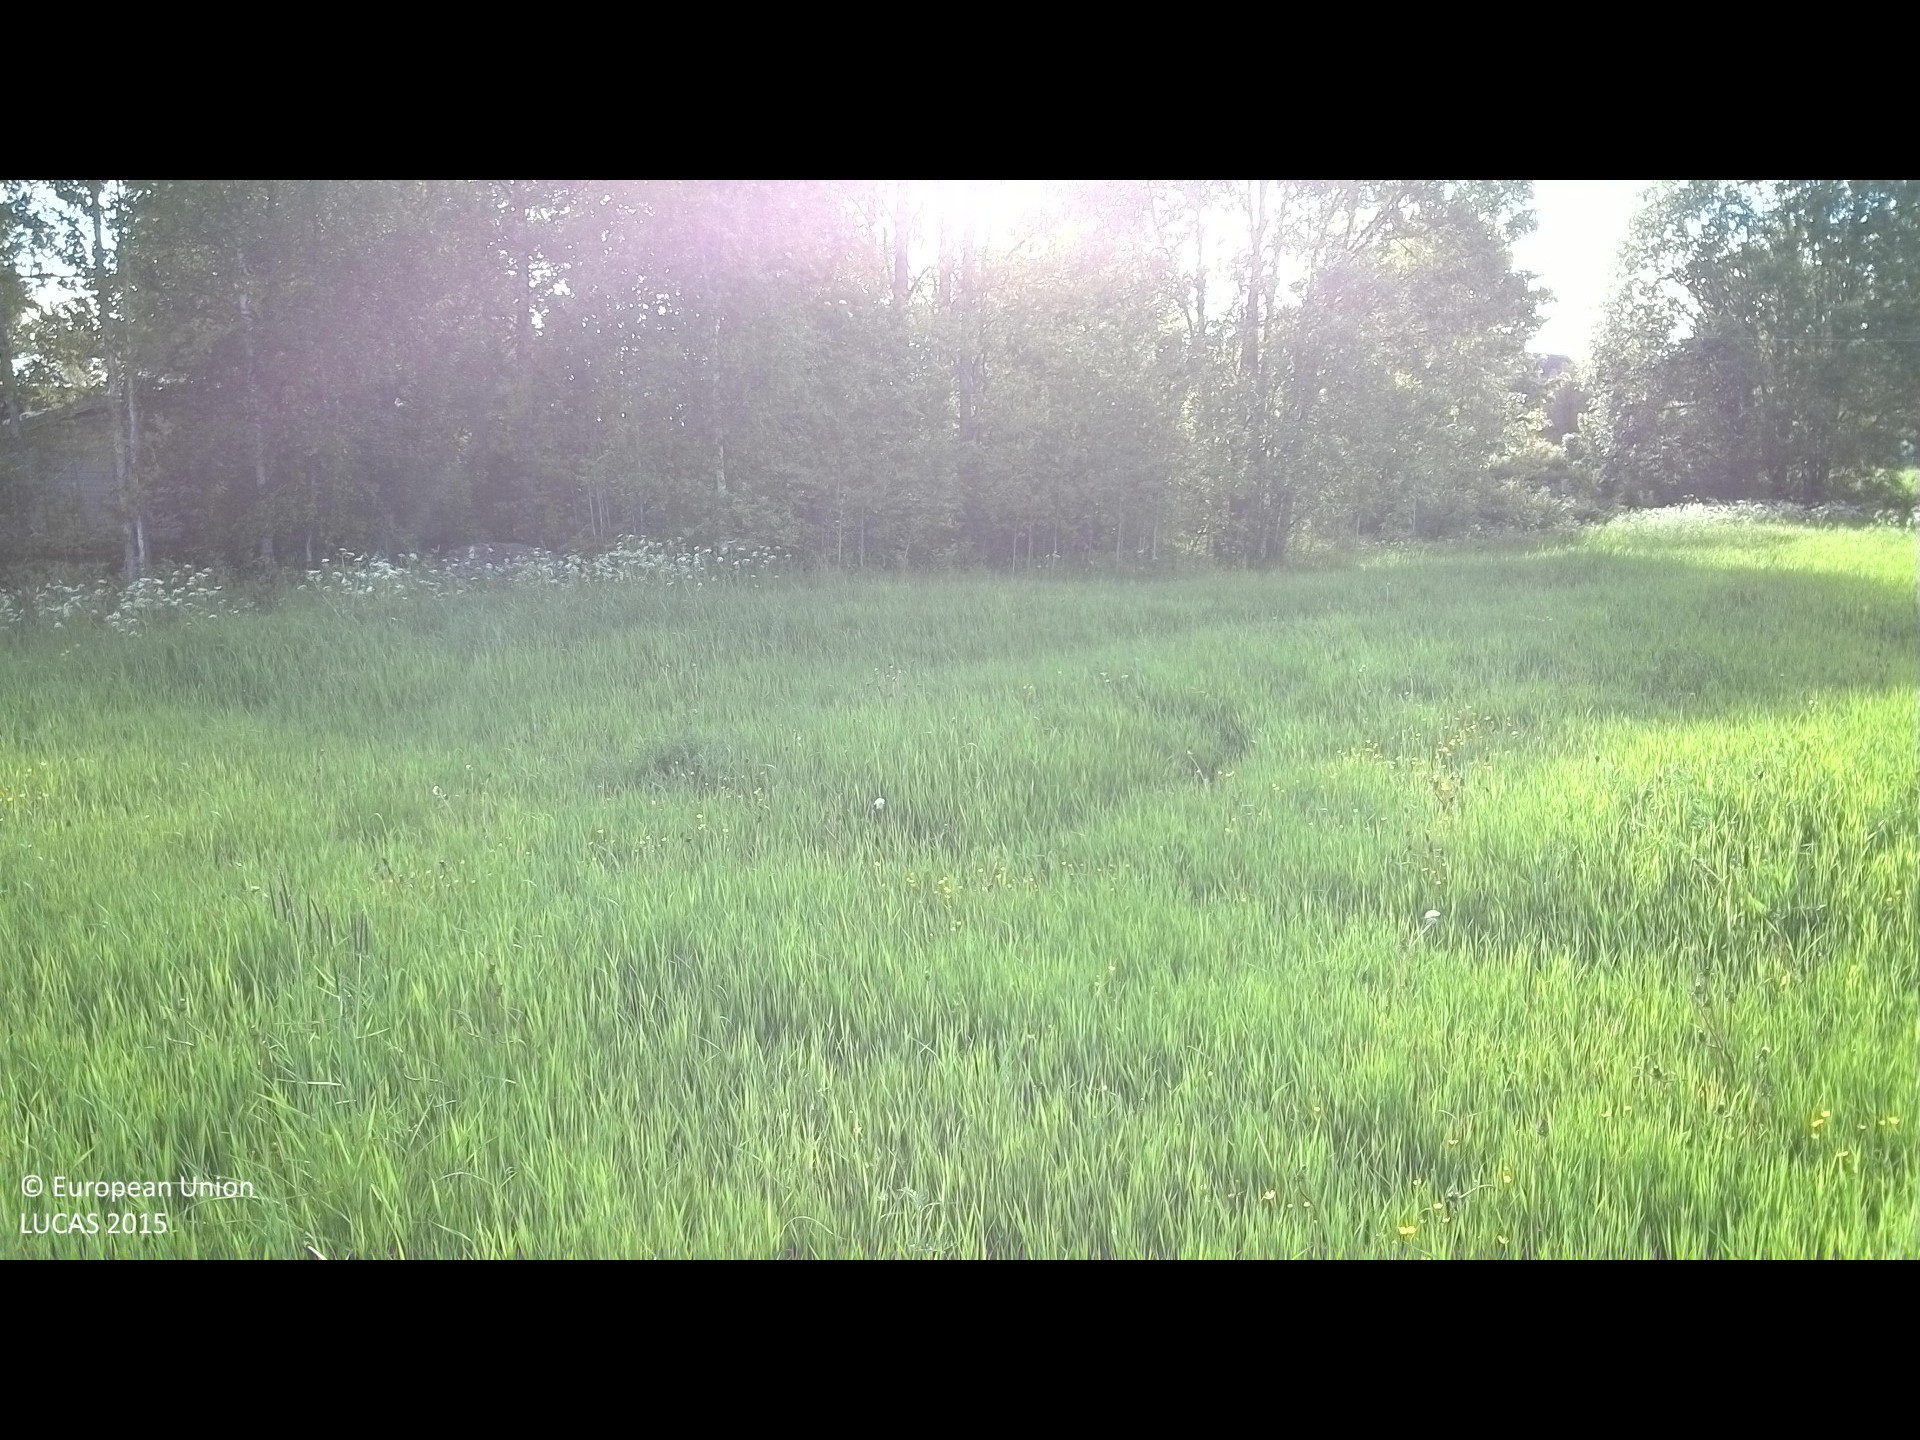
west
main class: Cropland
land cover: Other leguminous and mixtures for fodder
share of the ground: > 75 %
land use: Agriculture (excluding fallow land and kitchen gardens)
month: June
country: SE
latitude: 61.9310
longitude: 17.2413
